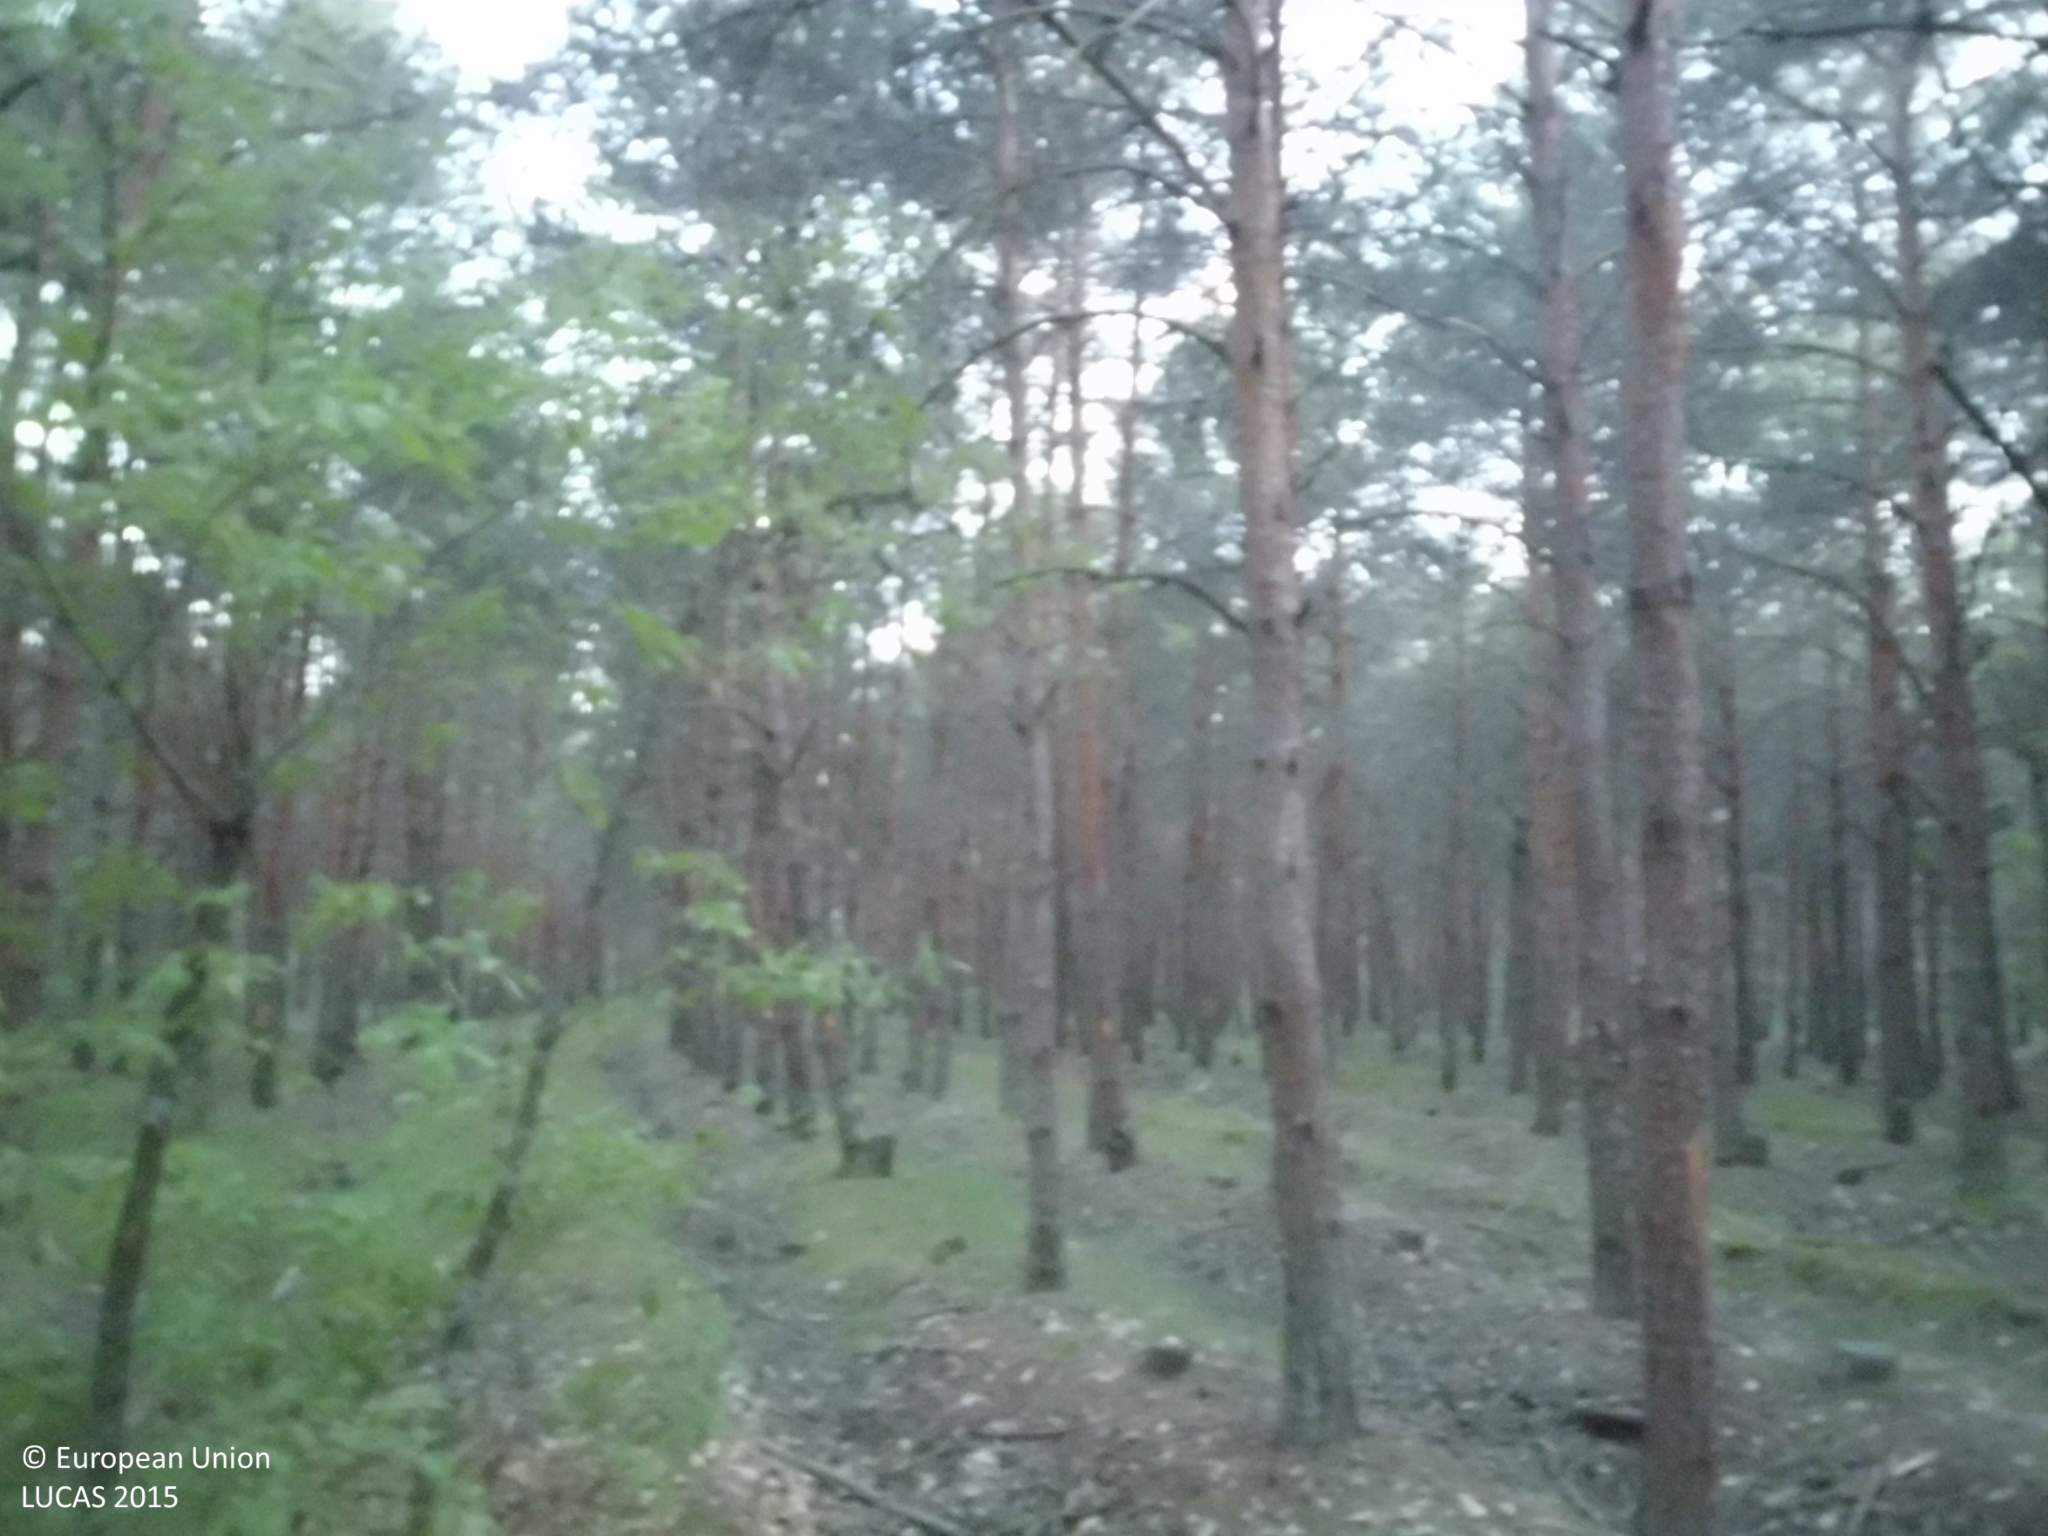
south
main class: Woodland
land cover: Pine dominated coniferous woodland
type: coniferous forest of the mediterranean region
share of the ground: > 75 %
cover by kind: coniferous forest trees 100 %
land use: Forestry
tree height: > 5 m
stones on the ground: > 50 %
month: May
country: ES
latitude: 42.5983
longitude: -4.8420
